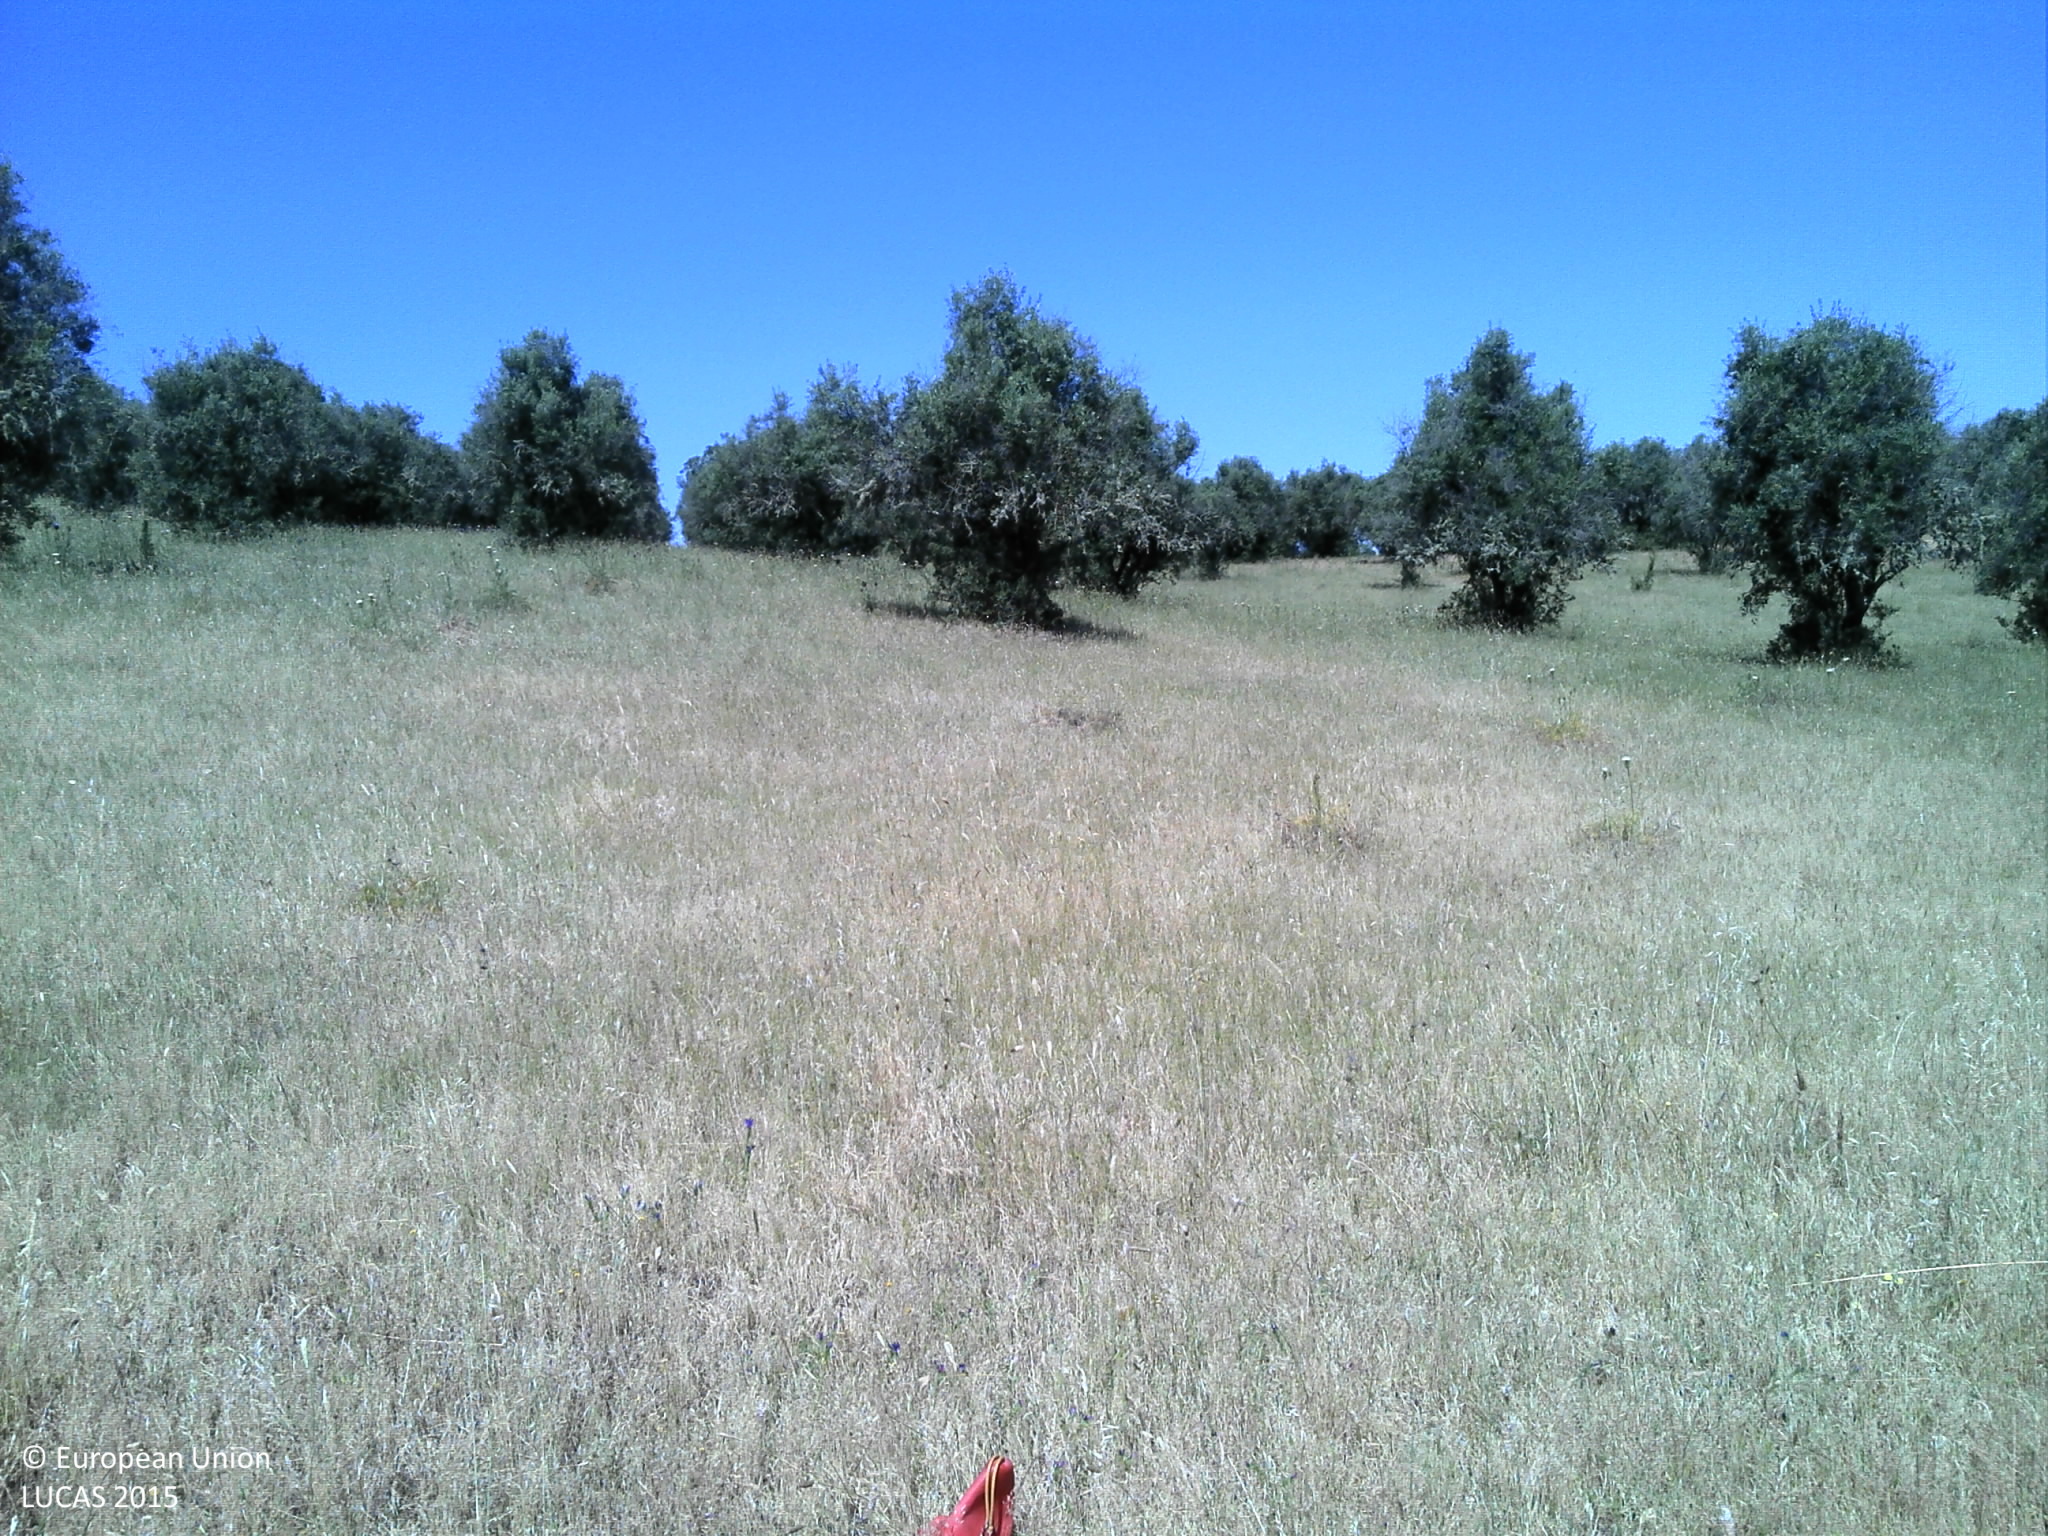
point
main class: Grassland
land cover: Grassland without tree/shrub cover
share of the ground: 50 - 75 %
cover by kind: herbaceous plants 75 %, unconsolidated bare surface 25 %
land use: Agriculture (excluding fallow land and kitchen gardens)
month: May
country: PT
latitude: 38.8578
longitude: -8.1311
